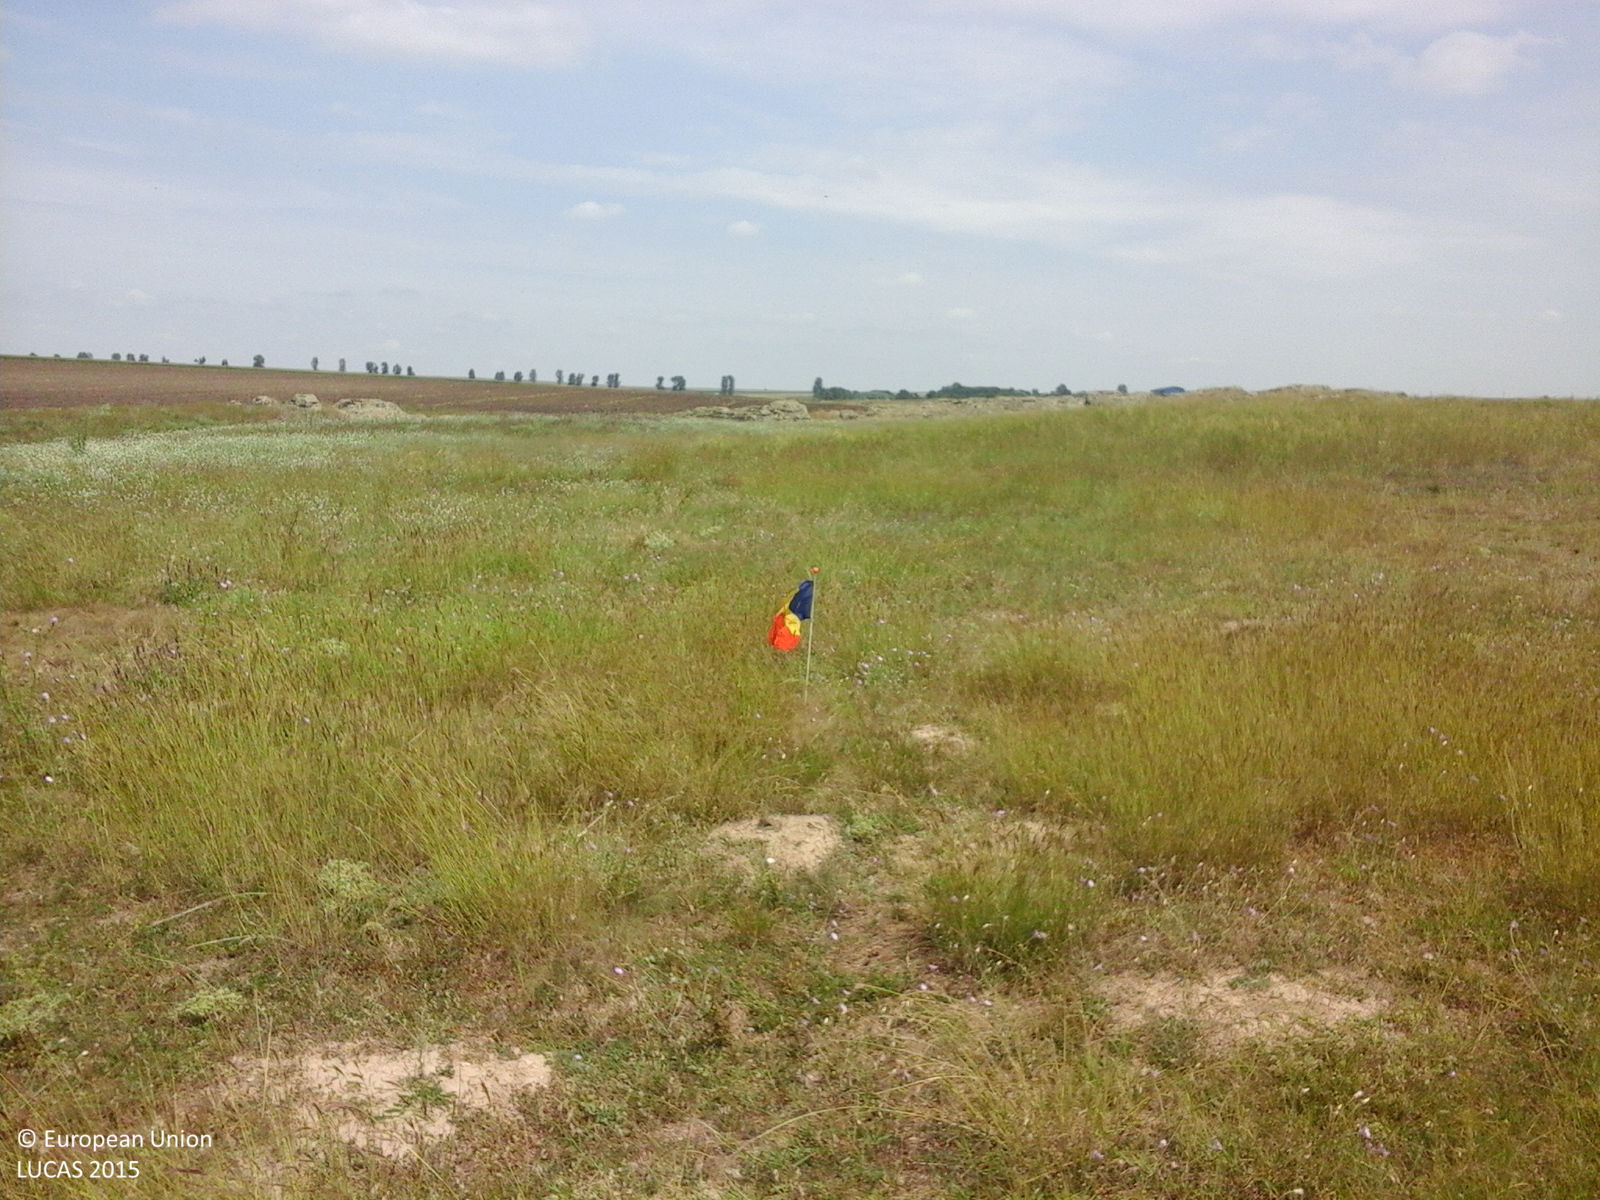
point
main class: Grassland
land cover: Spontaneously vegetated surfaces
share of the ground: > 75 %
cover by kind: herbaceous plants 100 %
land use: Fallow land
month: August
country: RO
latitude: 44.6852
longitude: 28.4826
